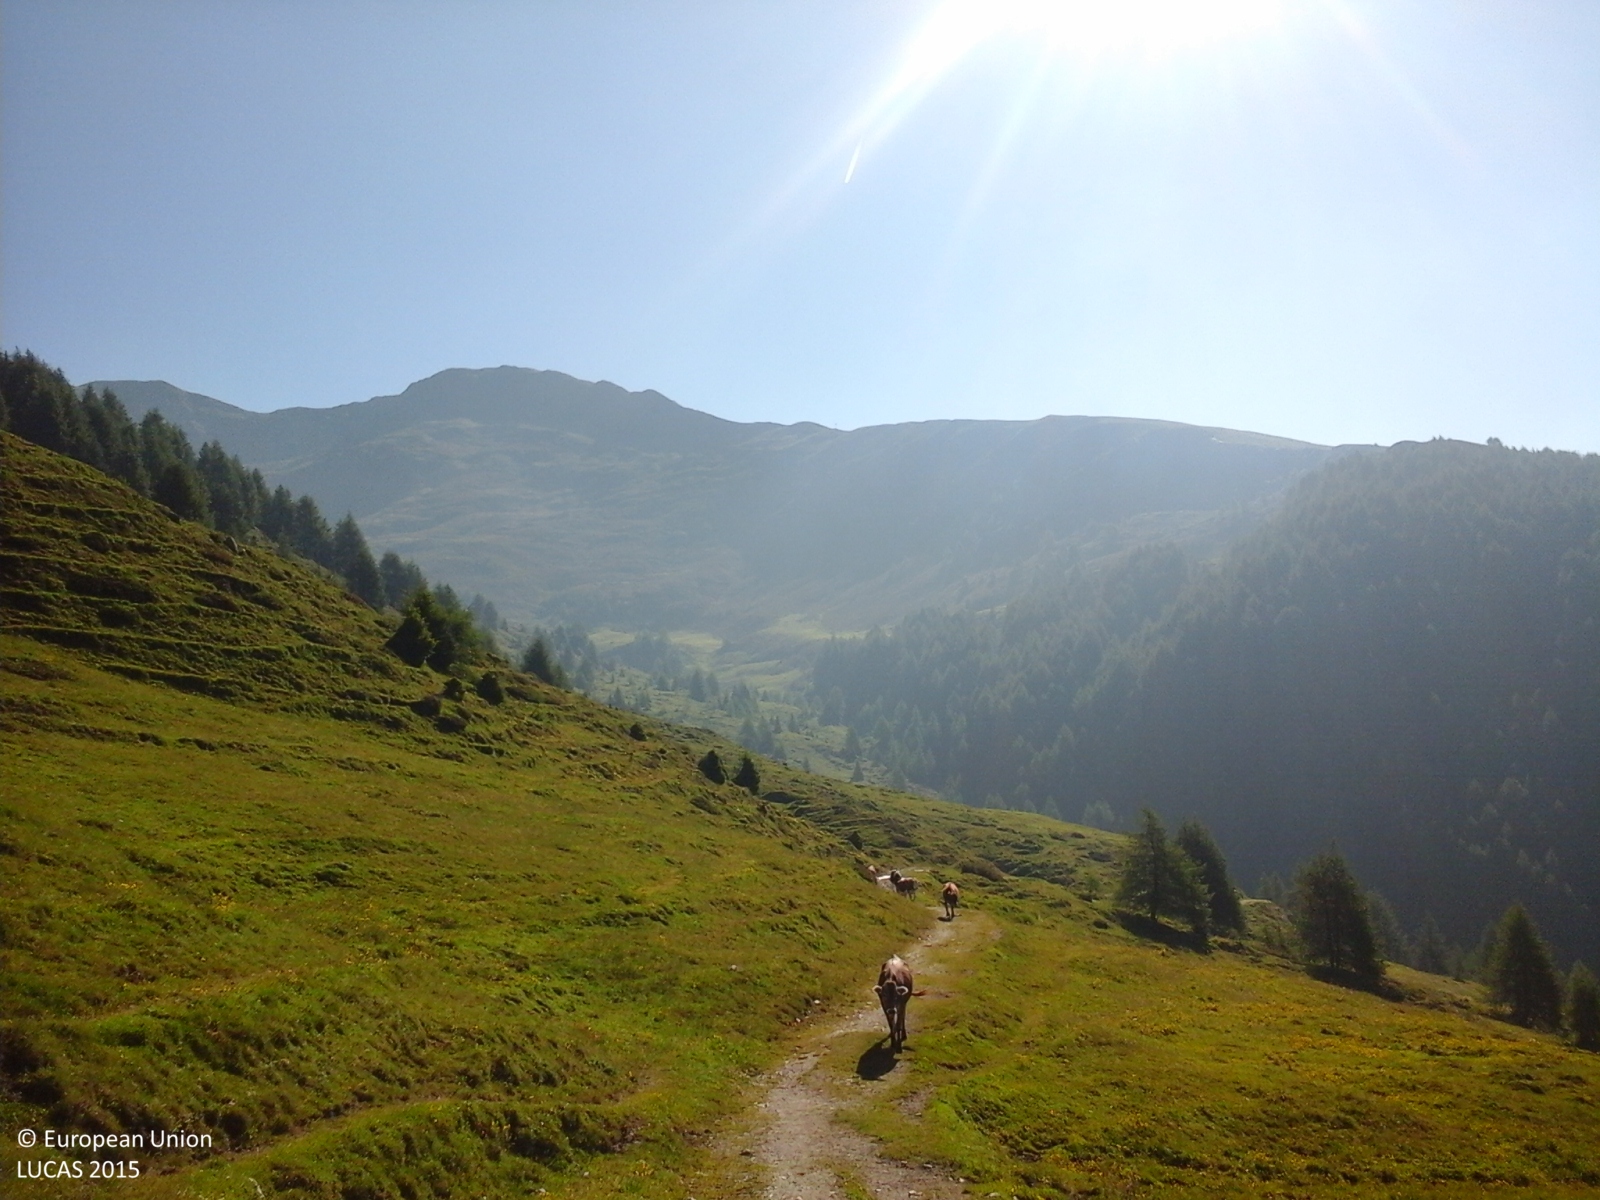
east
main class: Grassland
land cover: Grassland without tree/shrub cover
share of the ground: > 75 %
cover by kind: herbaceous plants 100 %
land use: Agriculture (excluding fallow land and kitchen gardens)
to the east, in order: Grassland without tree/shrub cover; Grassland with sparse tree/shrub cover; Grassland without tree/shrub cover
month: July
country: IT
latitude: 46.6843
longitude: 12.4163
